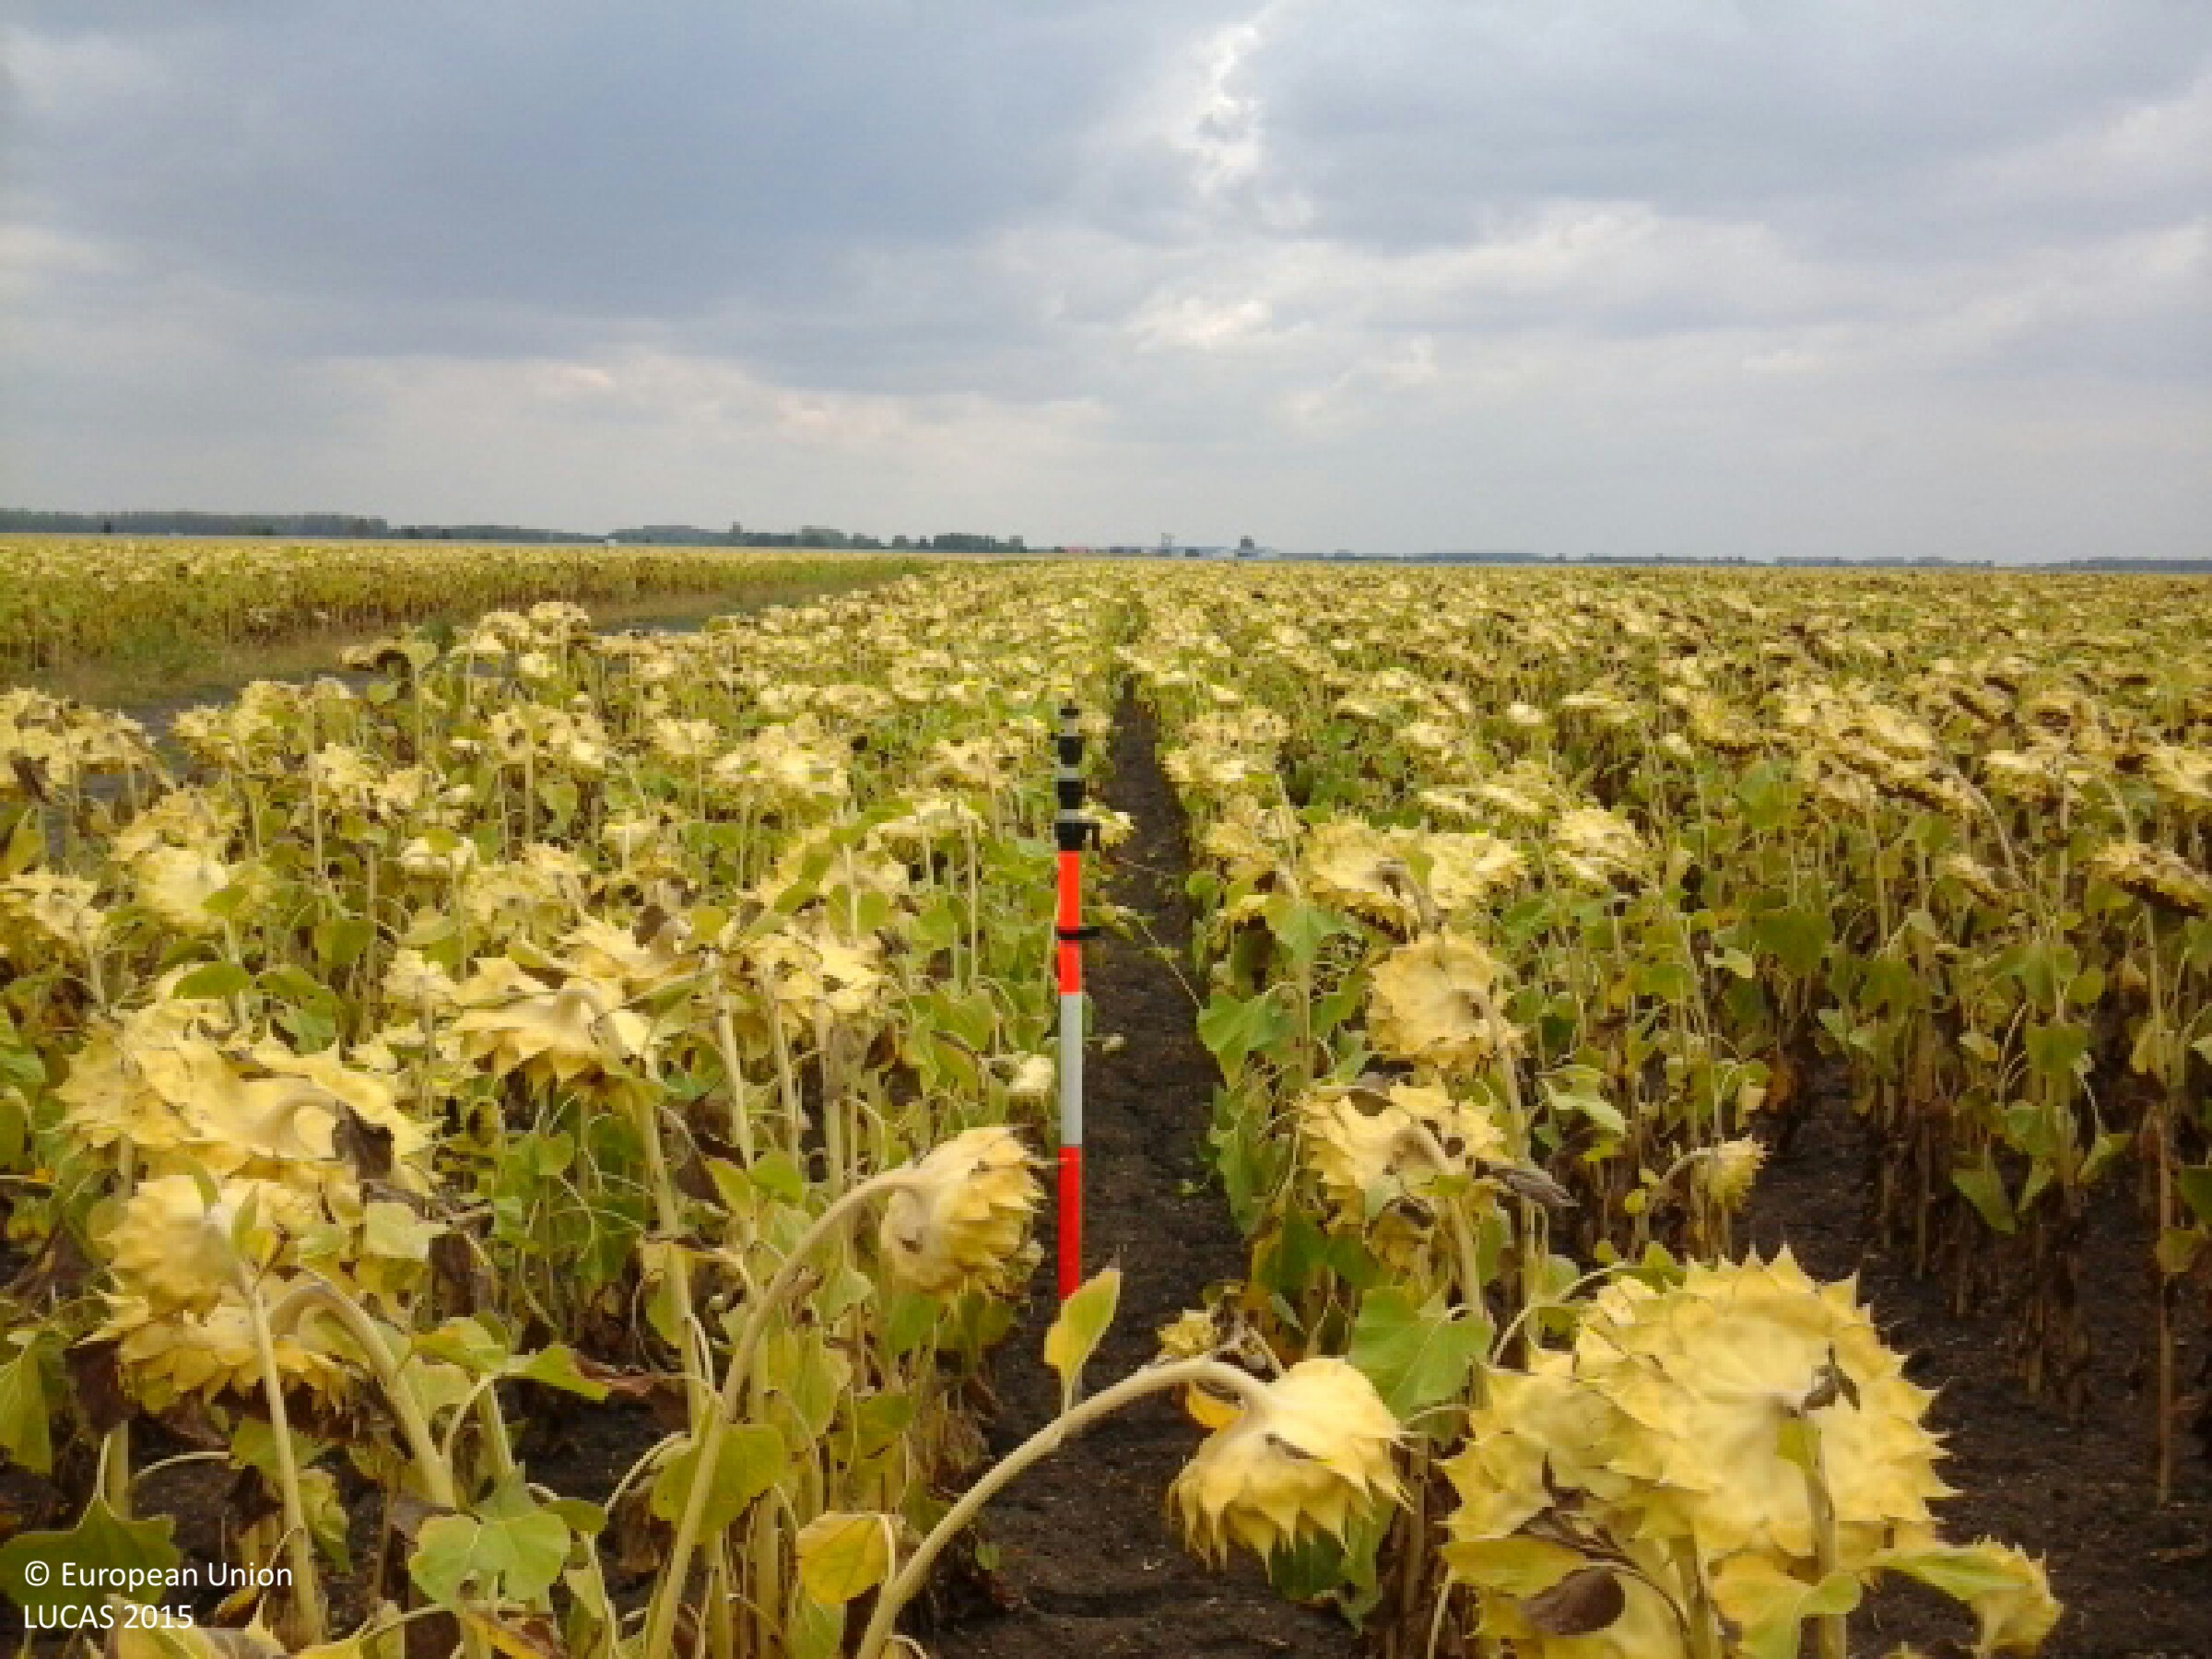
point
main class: Cropland
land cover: Sunflower
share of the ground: > 75 %
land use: Agriculture (excluding fallow land and kitchen gardens)
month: August
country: HU
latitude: 47.1477
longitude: 21.6613
